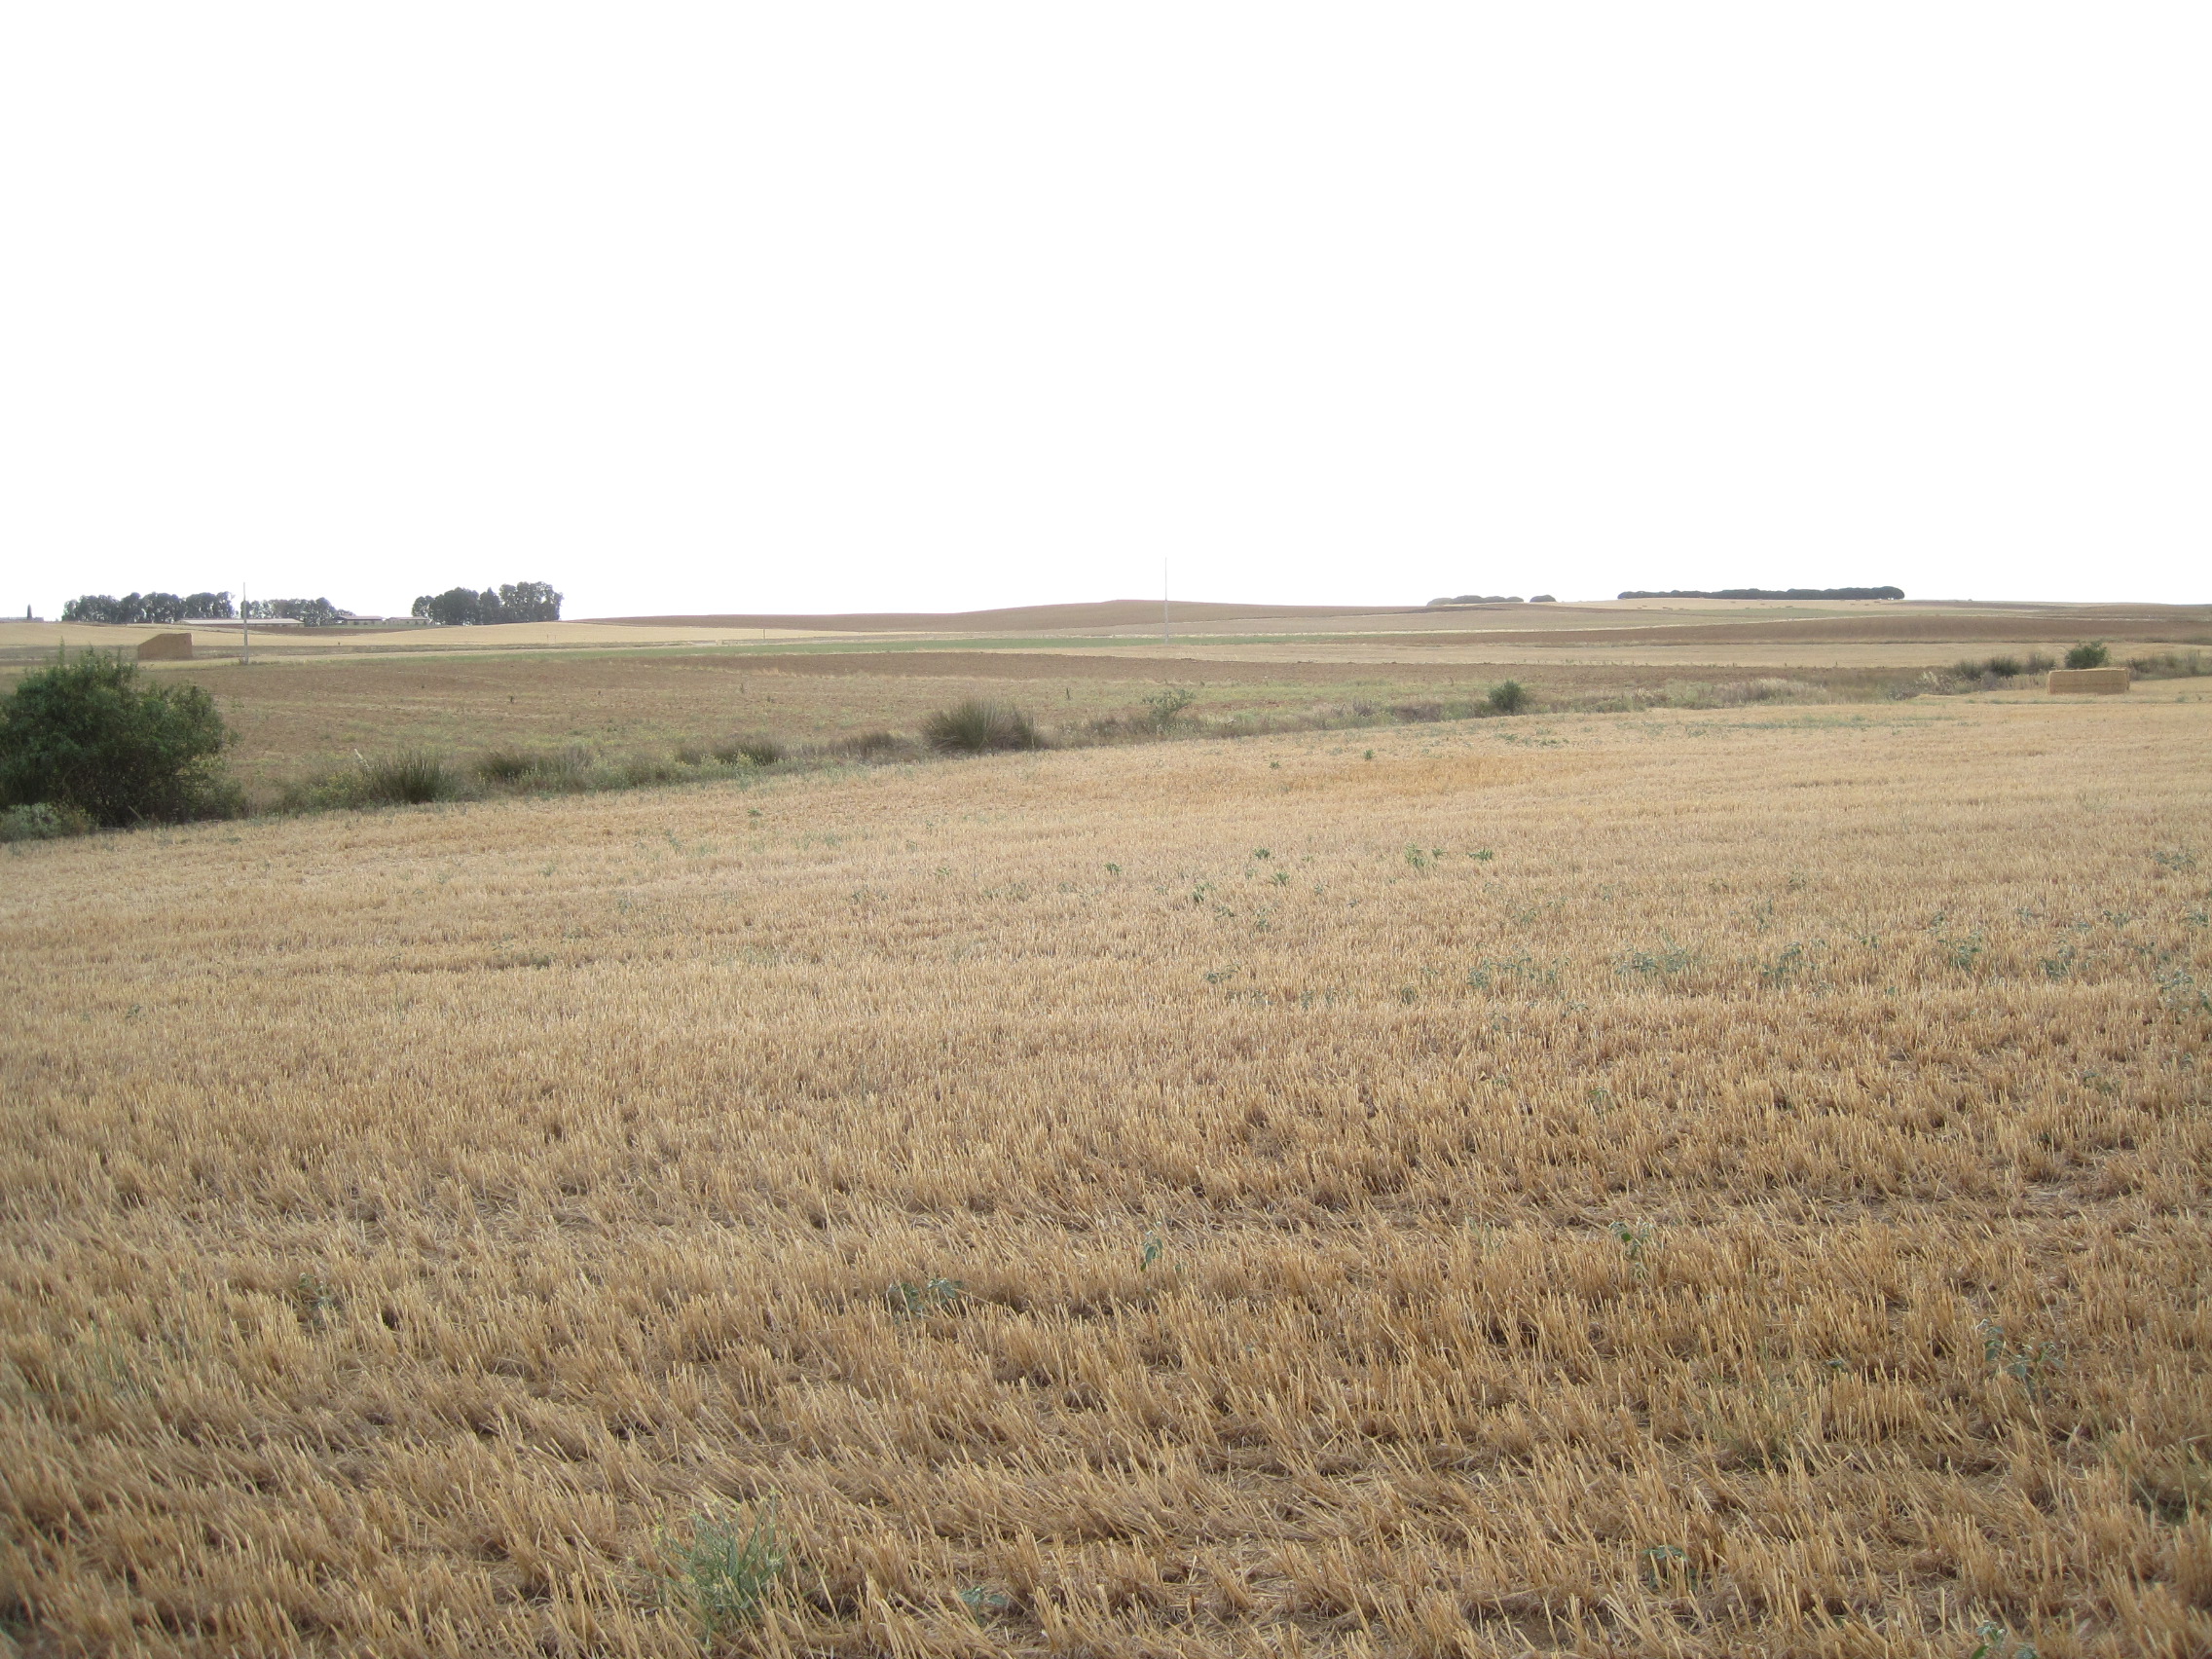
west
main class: Cropland
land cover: Barley
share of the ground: < 10 %
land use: Agriculture (excluding fallow land and kitchen gardens)
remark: Harvested field
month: July
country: ES
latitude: 41.9251
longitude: -5.4119
